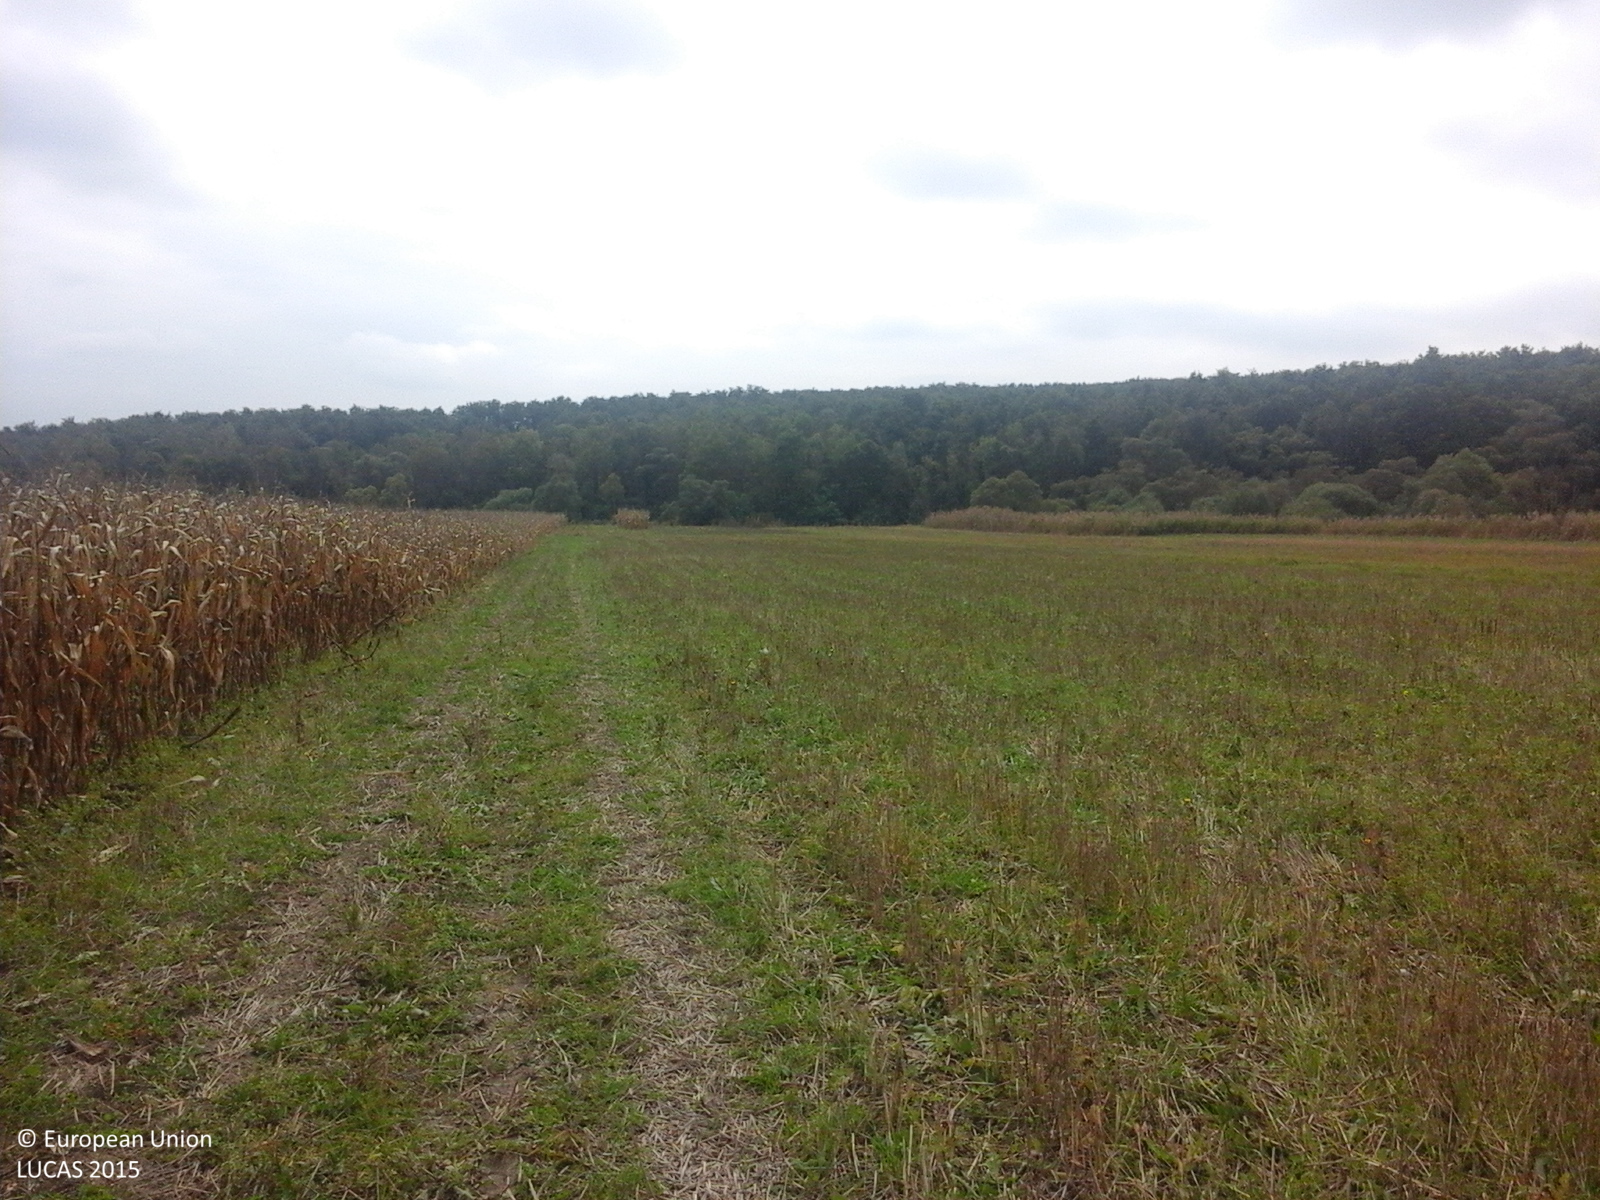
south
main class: Cropland
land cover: Common wheat
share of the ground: 25 - 50 %
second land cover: Spontaneously vegetated surfaces
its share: 50 - 75 %
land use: Agriculture (excluding fallow land and kitchen gardens)
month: October
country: RO
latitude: 45.9734
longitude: 25.1850
